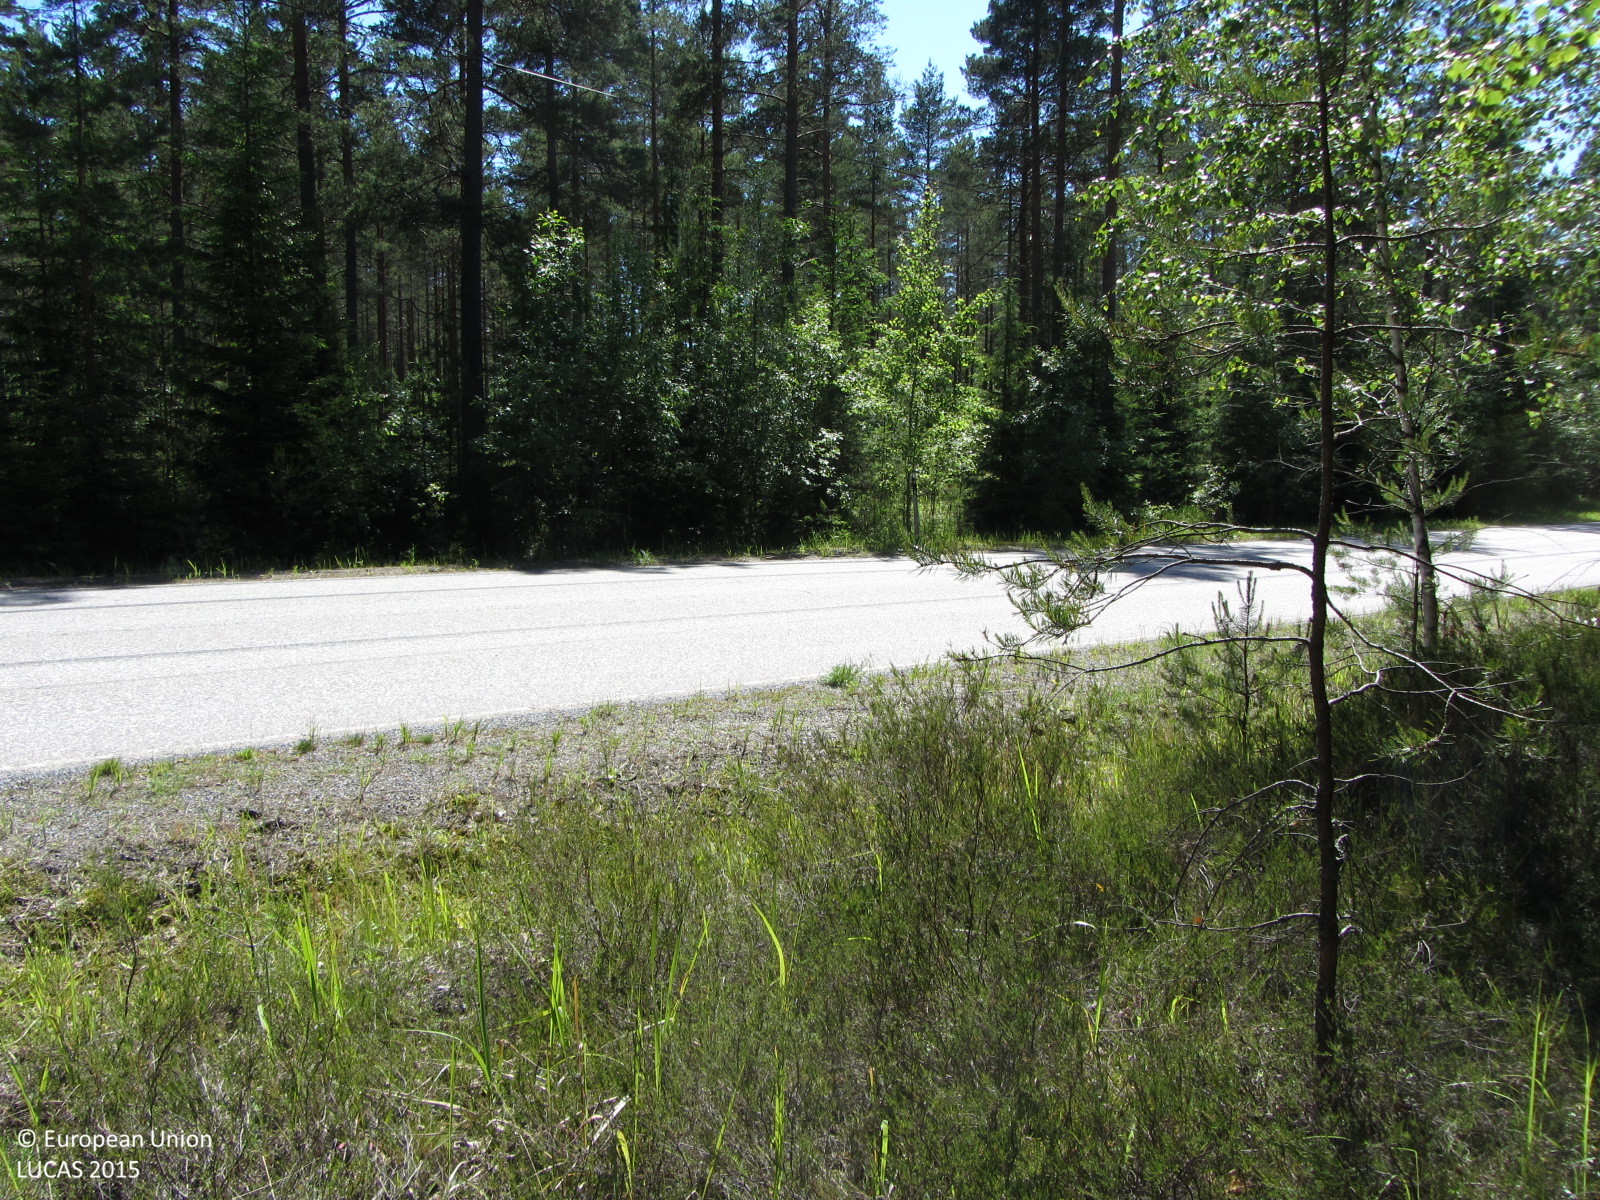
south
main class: Woodland
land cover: Pine dominated coniferous woodland
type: boreal forest
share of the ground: > 75 %
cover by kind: coniferous forest trees 80 %, broadleaved forest trees 10 %, shrubs 5 %, herbaceous plants 5 %
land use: Forestry
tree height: > 5 m
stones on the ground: < 10 %
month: July
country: FI
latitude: 59.9303
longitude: 23.3097
